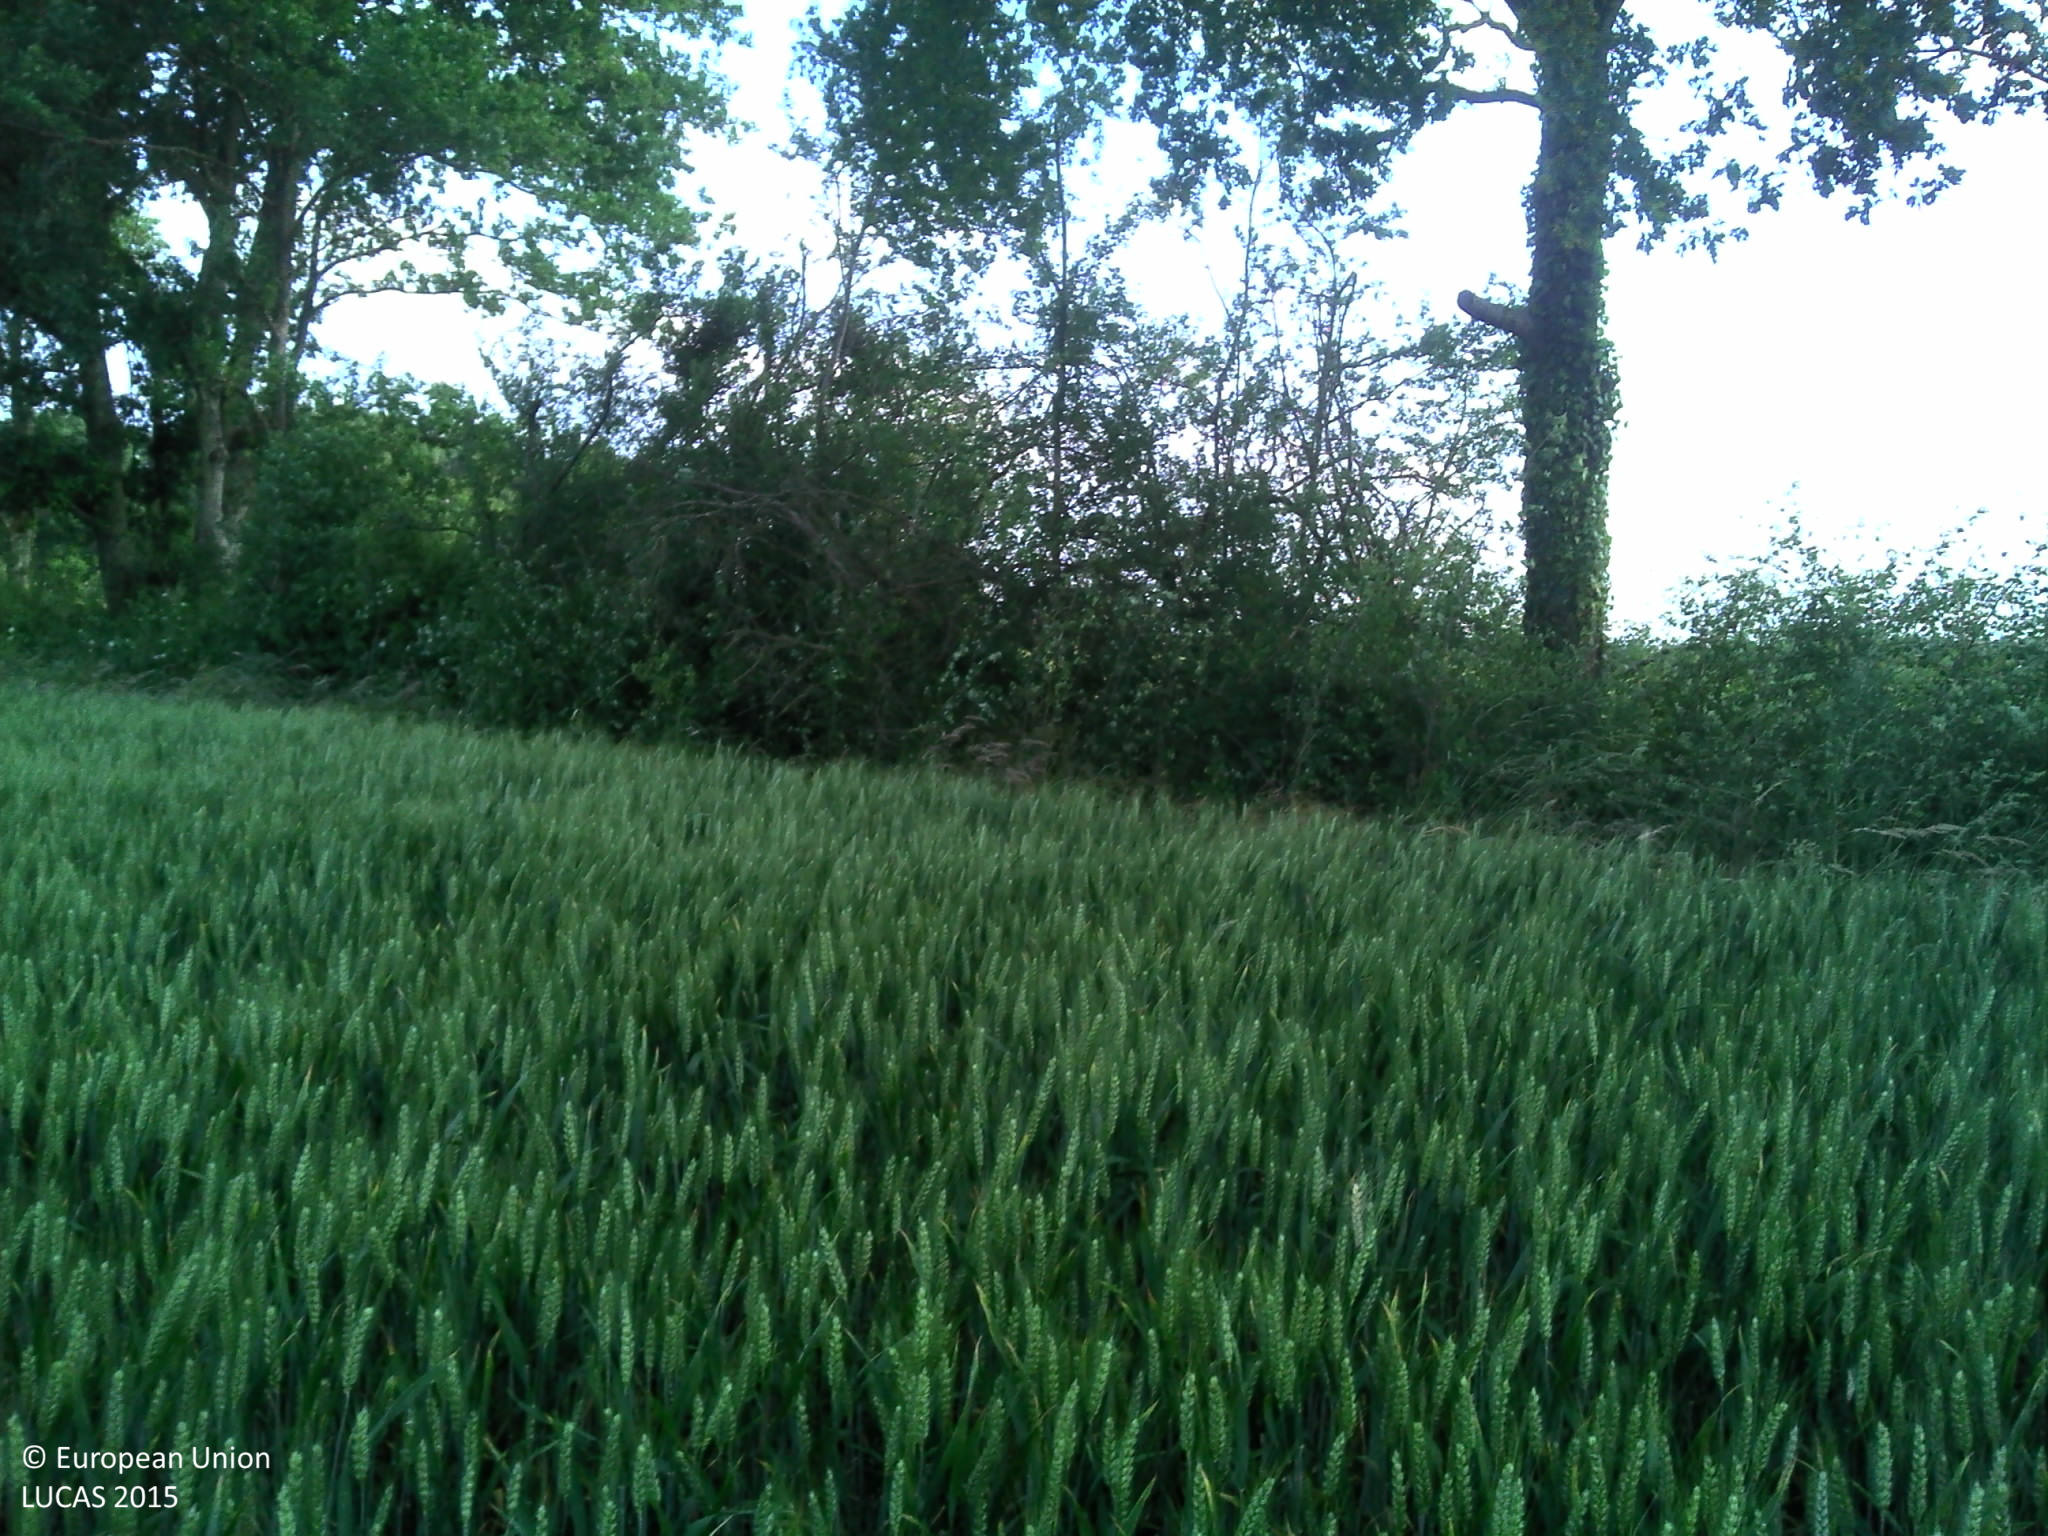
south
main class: Cropland
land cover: Common wheat
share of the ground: > 75 %
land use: Agriculture (excluding fallow land and kitchen gardens)
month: June
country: FR
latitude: 47.5391
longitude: 0.0772
